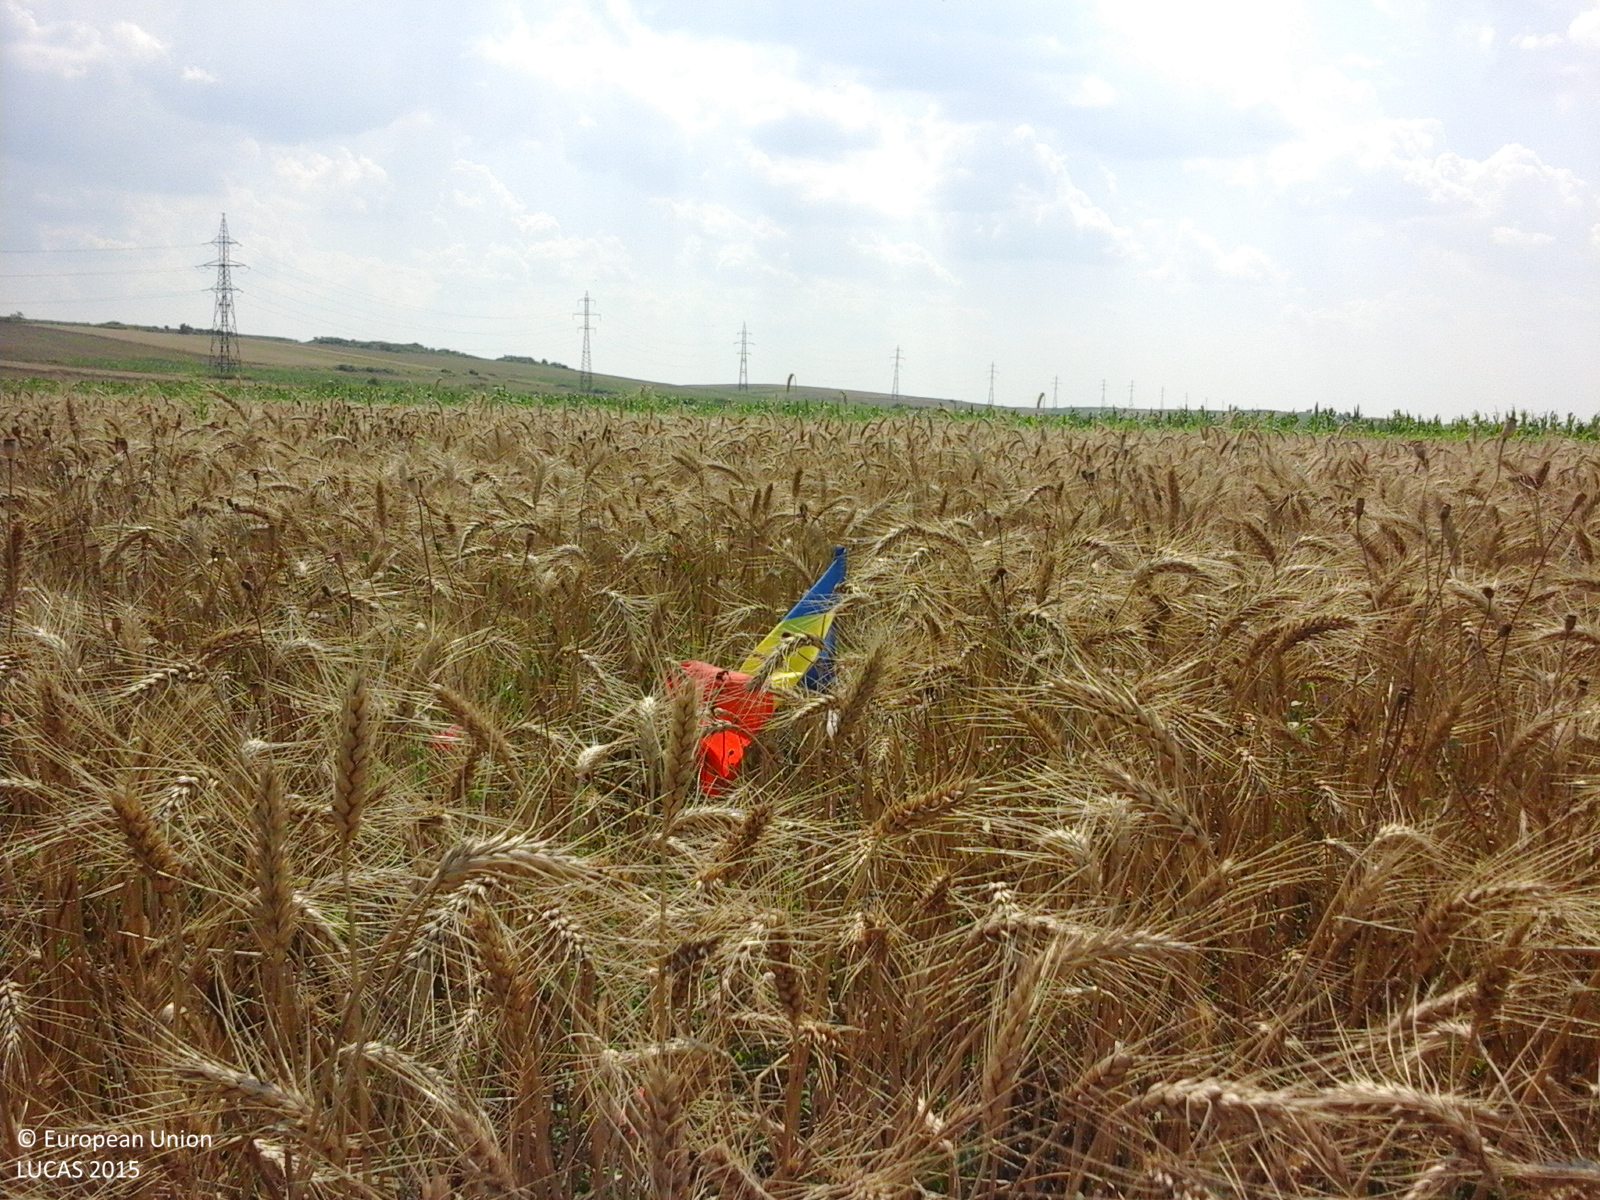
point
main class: Cropland
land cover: Common wheat
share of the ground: > 75 %
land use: Agriculture (excluding fallow land and kitchen gardens)
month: July
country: RO
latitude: 44.0132
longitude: 25.1858
